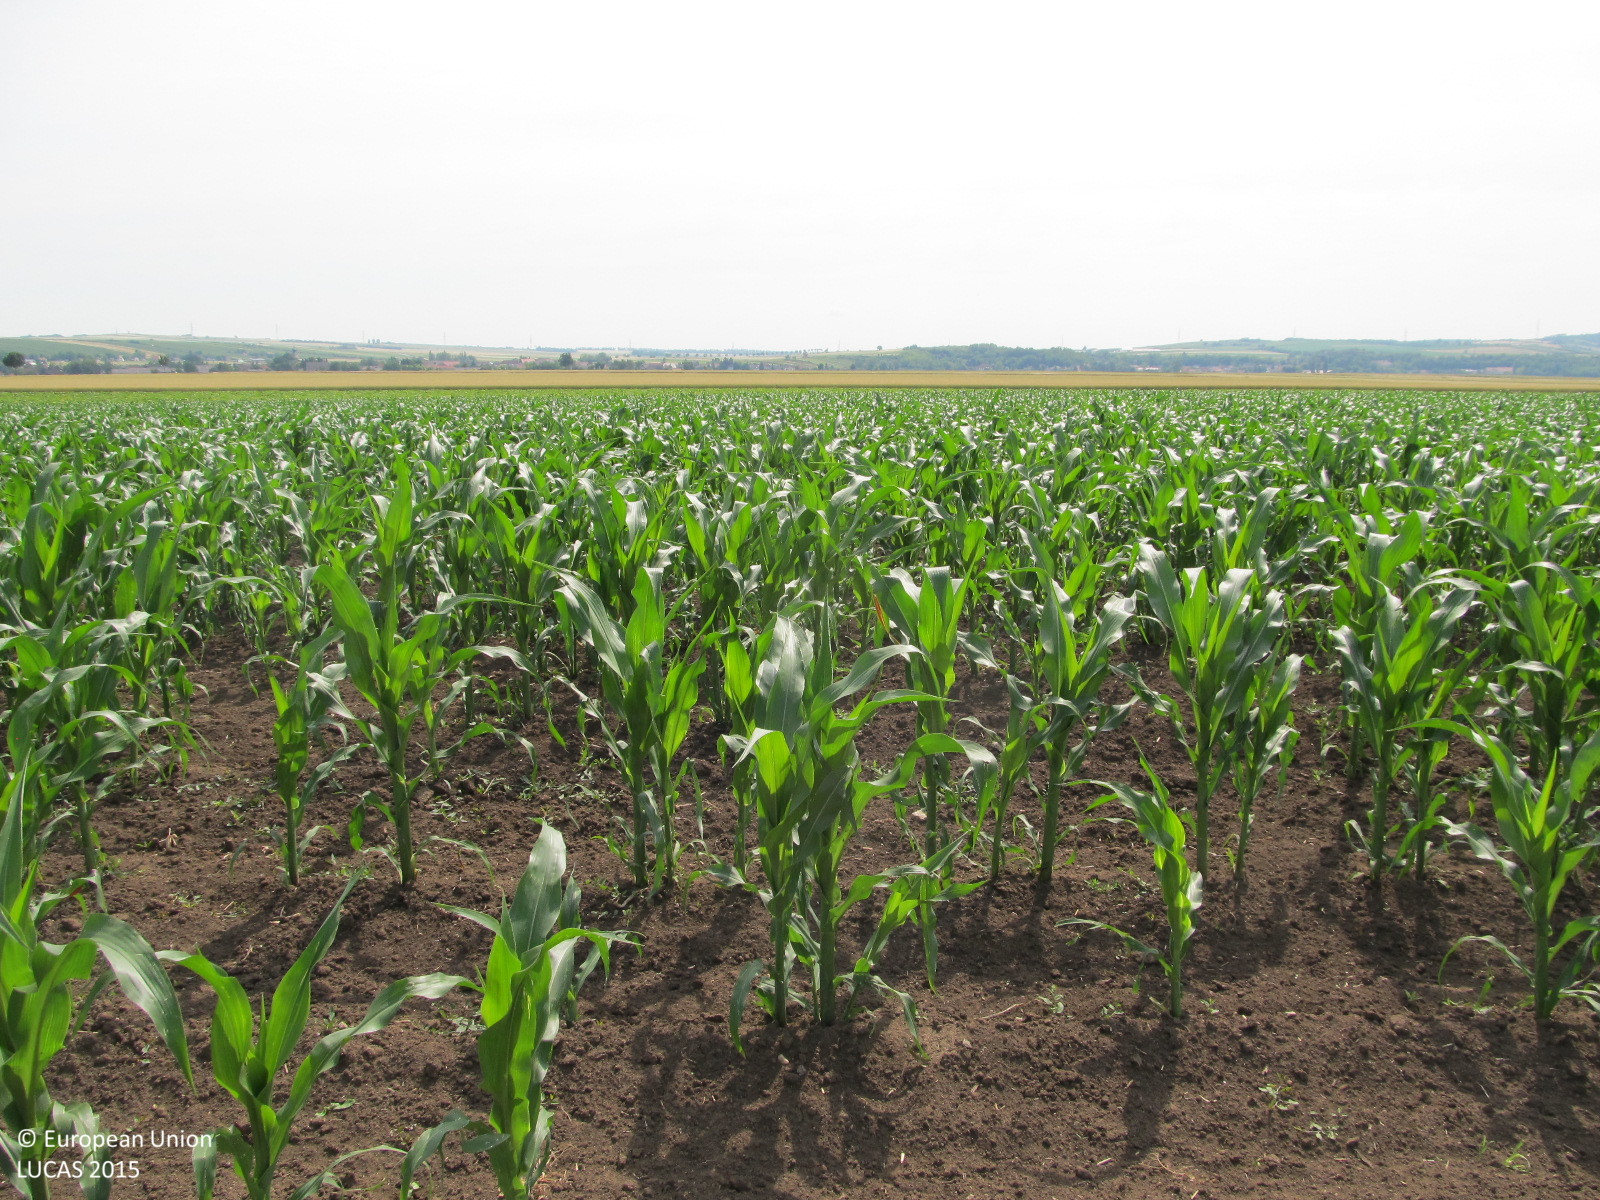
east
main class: Cropland
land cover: Barley
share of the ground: > 75 %
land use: Agriculture (excluding fallow land and kitchen gardens)
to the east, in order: Barley; Maize; Other fibre and oleaginous crops
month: June
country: AT
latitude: 48.6424
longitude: 15.9079
